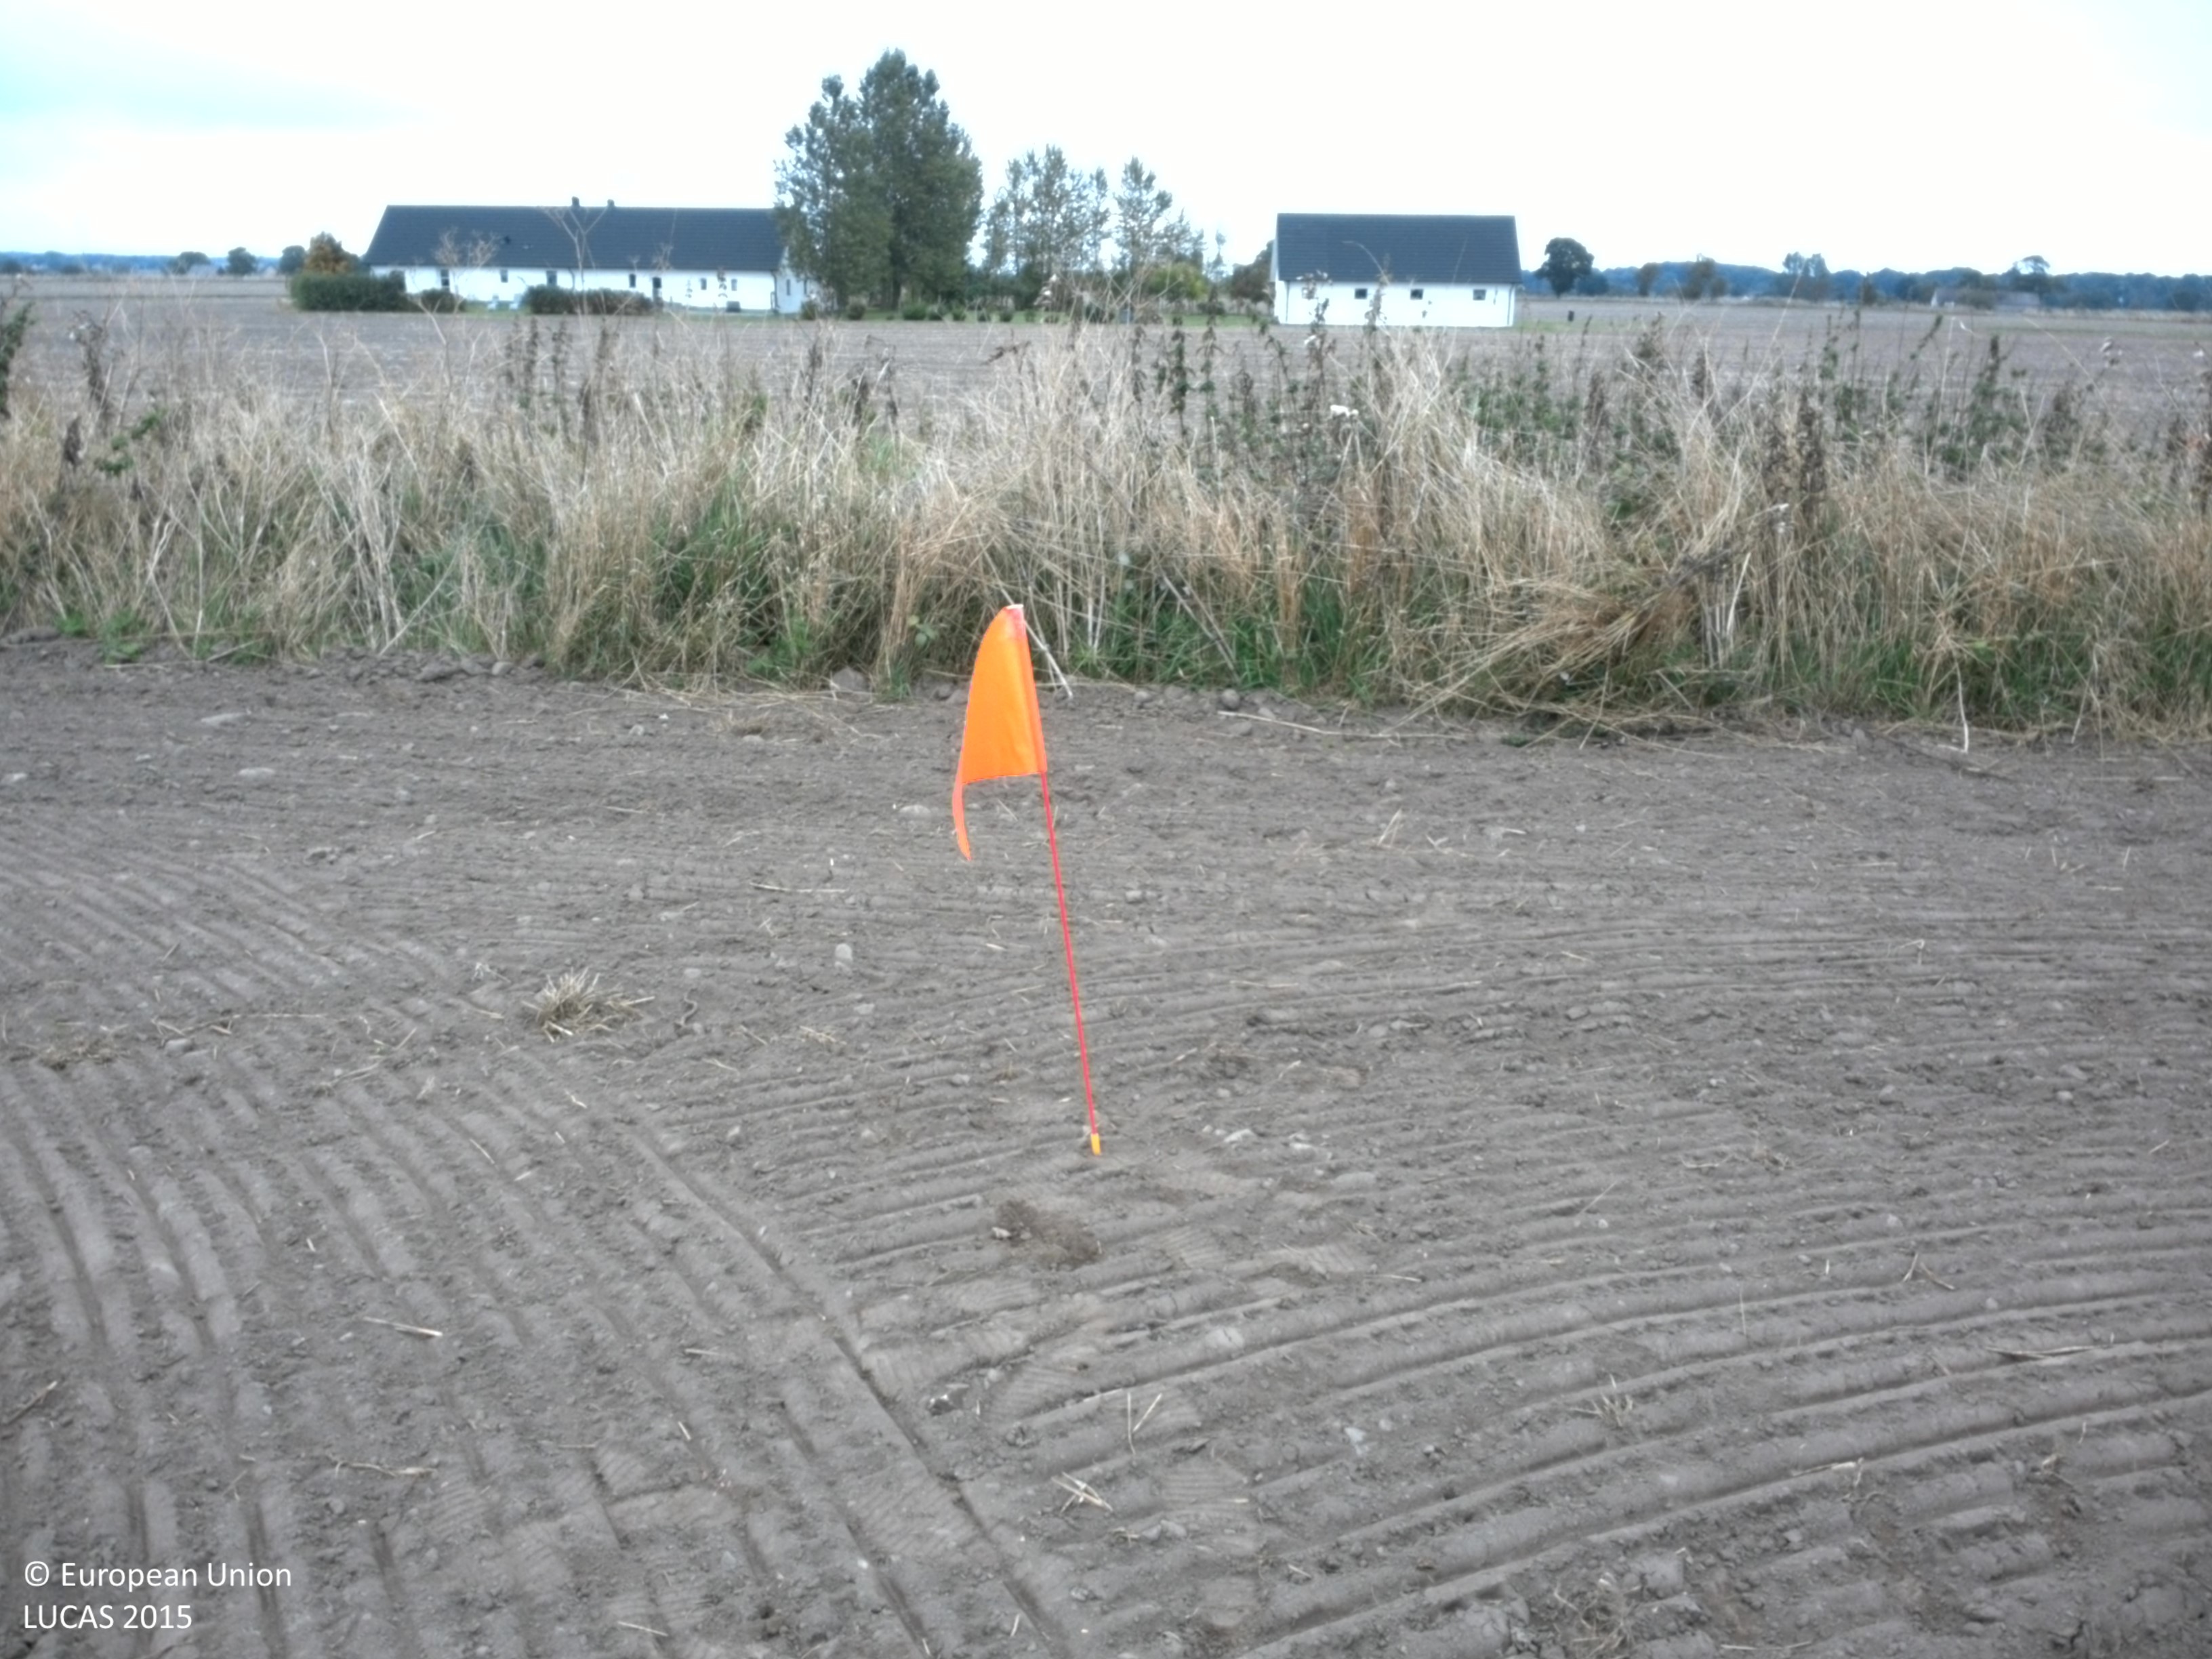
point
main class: Cropland
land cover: Common wheat
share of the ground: < 10 %
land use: Agriculture (excluding fallow land and kitchen gardens)
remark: Tilled/Sowed
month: October
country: SE
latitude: 55.5662
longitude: 14.0421
